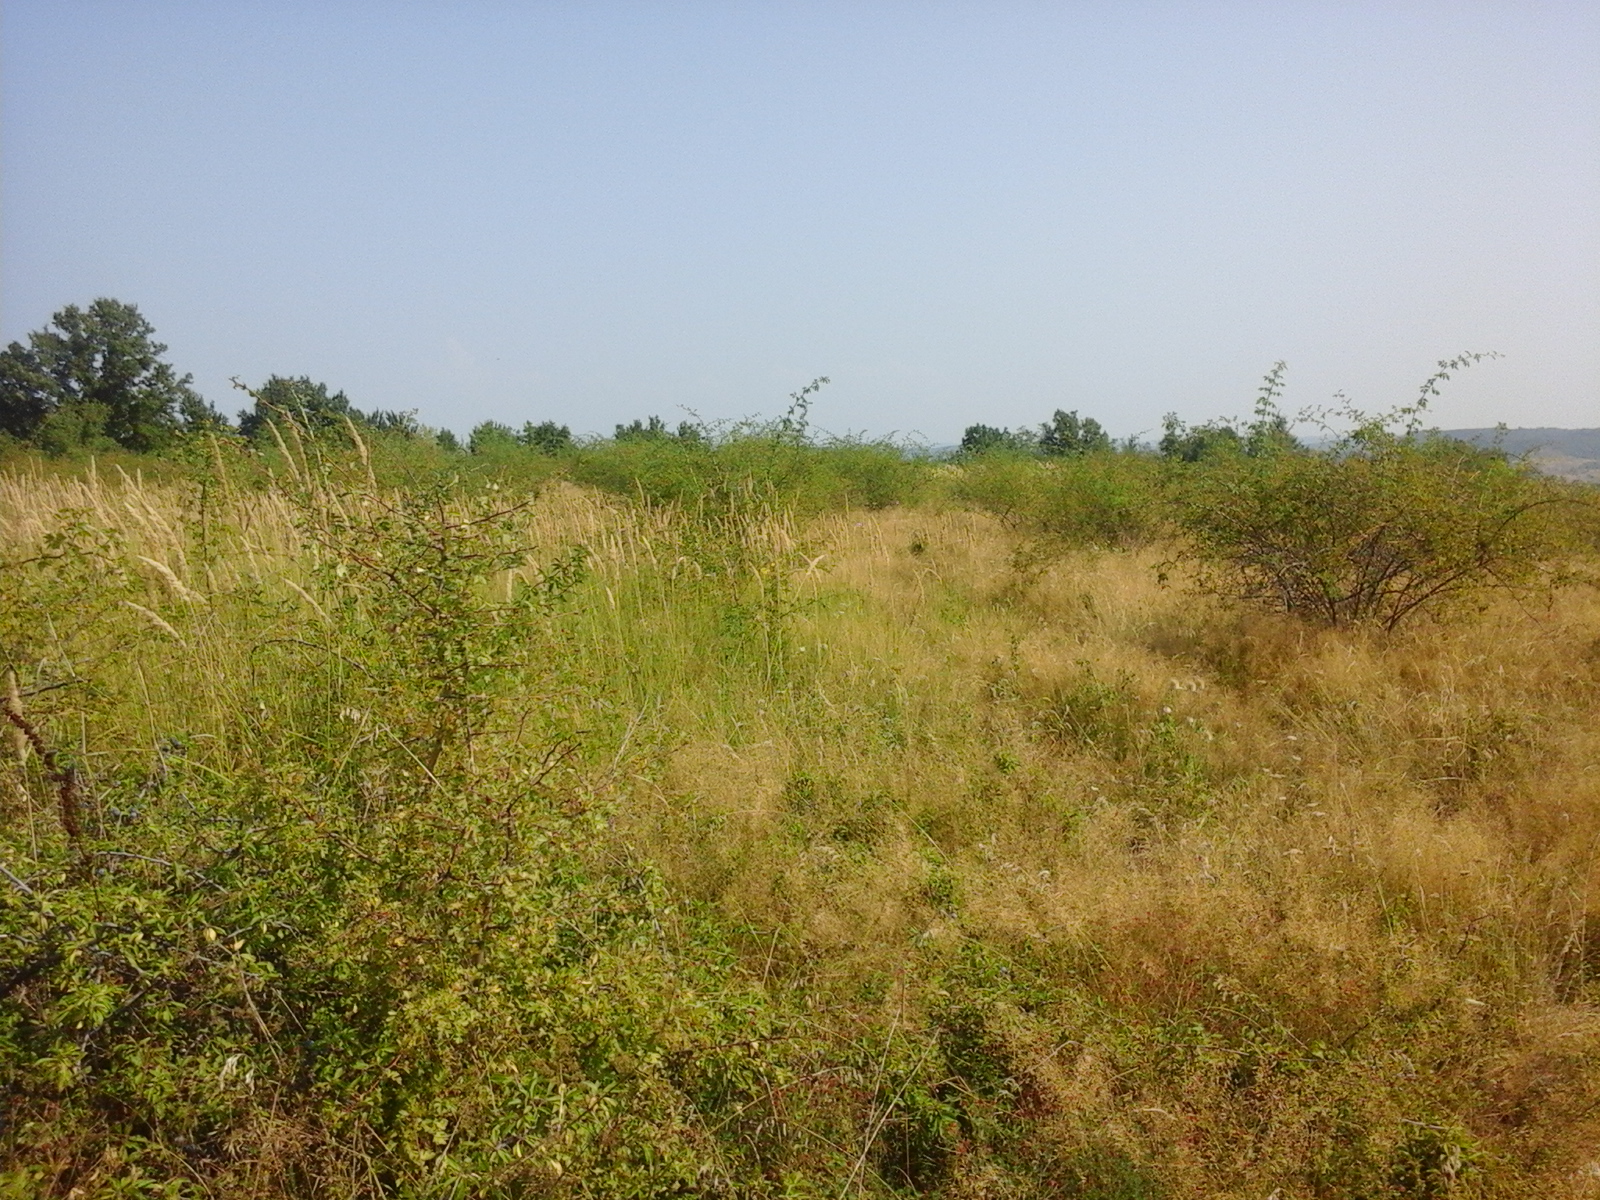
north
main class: Grassland
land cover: Grassland with sparse tree/shrub cover
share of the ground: > 75 %
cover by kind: herbaceous plants 95 %, broadleaved forest trees 5 %
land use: Agriculture (excluding fallow land and kitchen gardens)
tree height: < 5 m
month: August
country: RO
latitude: 44.7518
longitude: 23.8421
